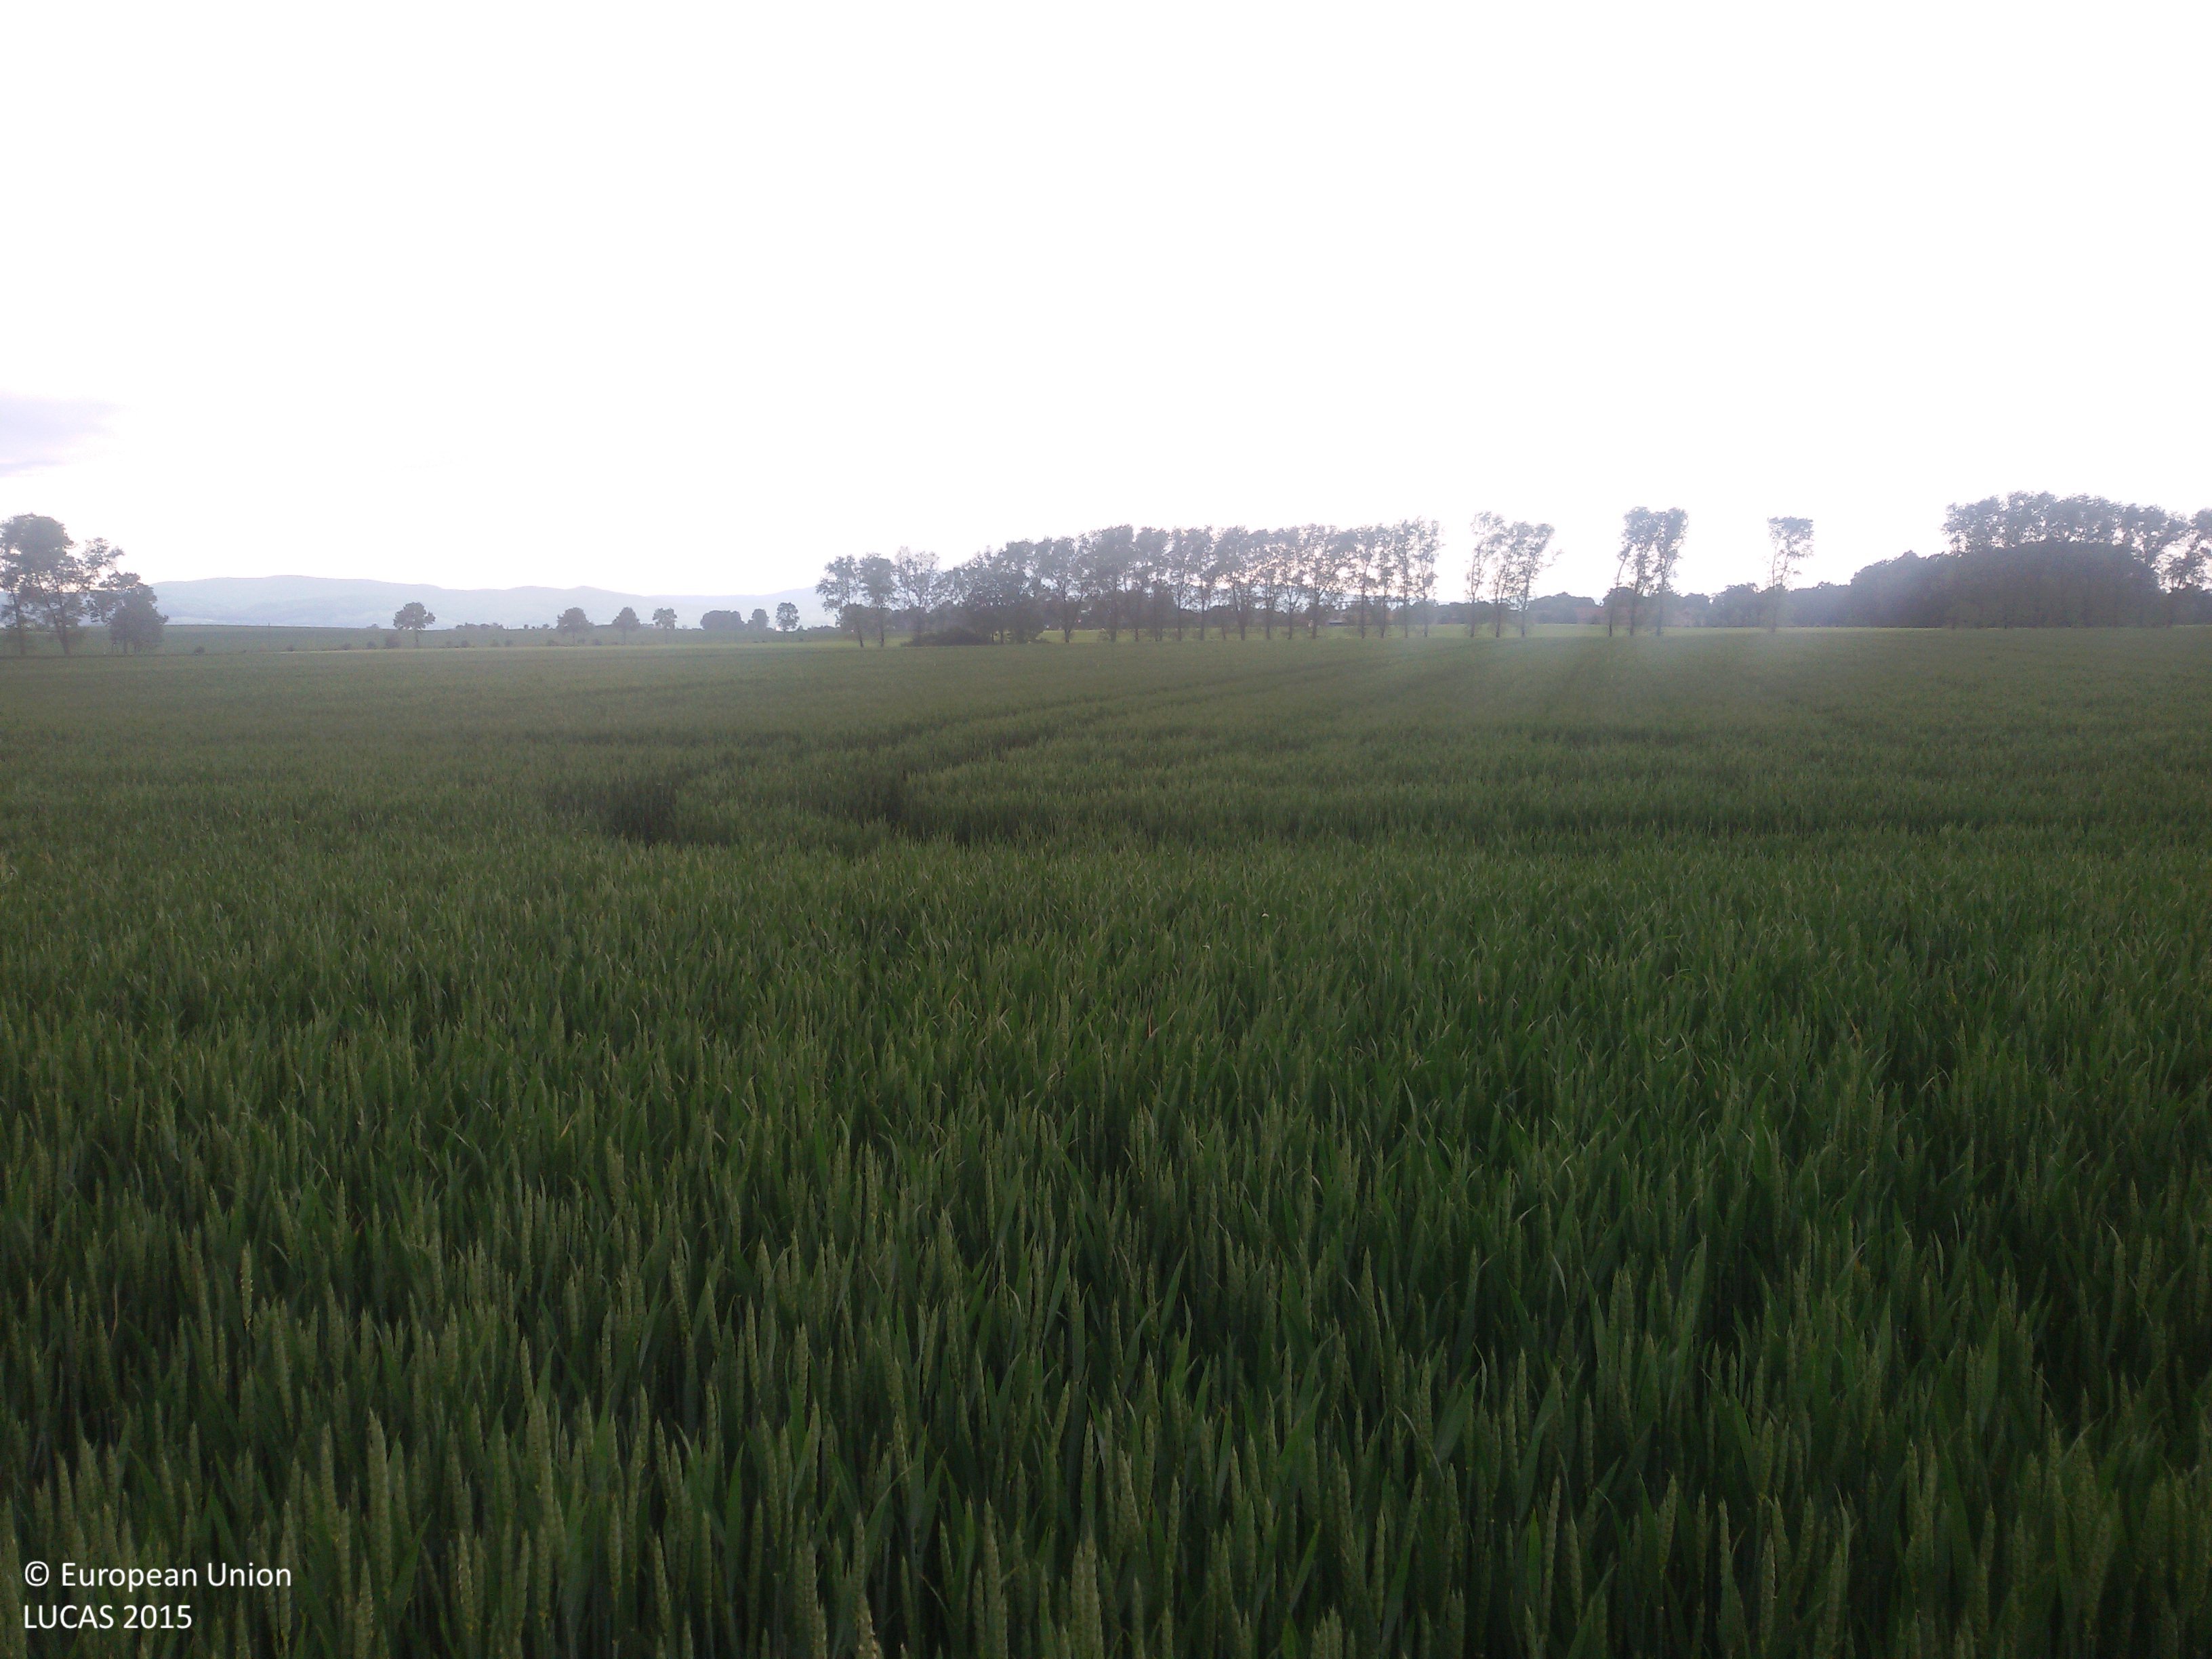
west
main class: Cropland
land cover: Common wheat
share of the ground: > 75 %
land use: Agriculture (excluding fallow land and kitchen gardens)
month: May
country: PL
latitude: 50.4095
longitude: 17.1732
